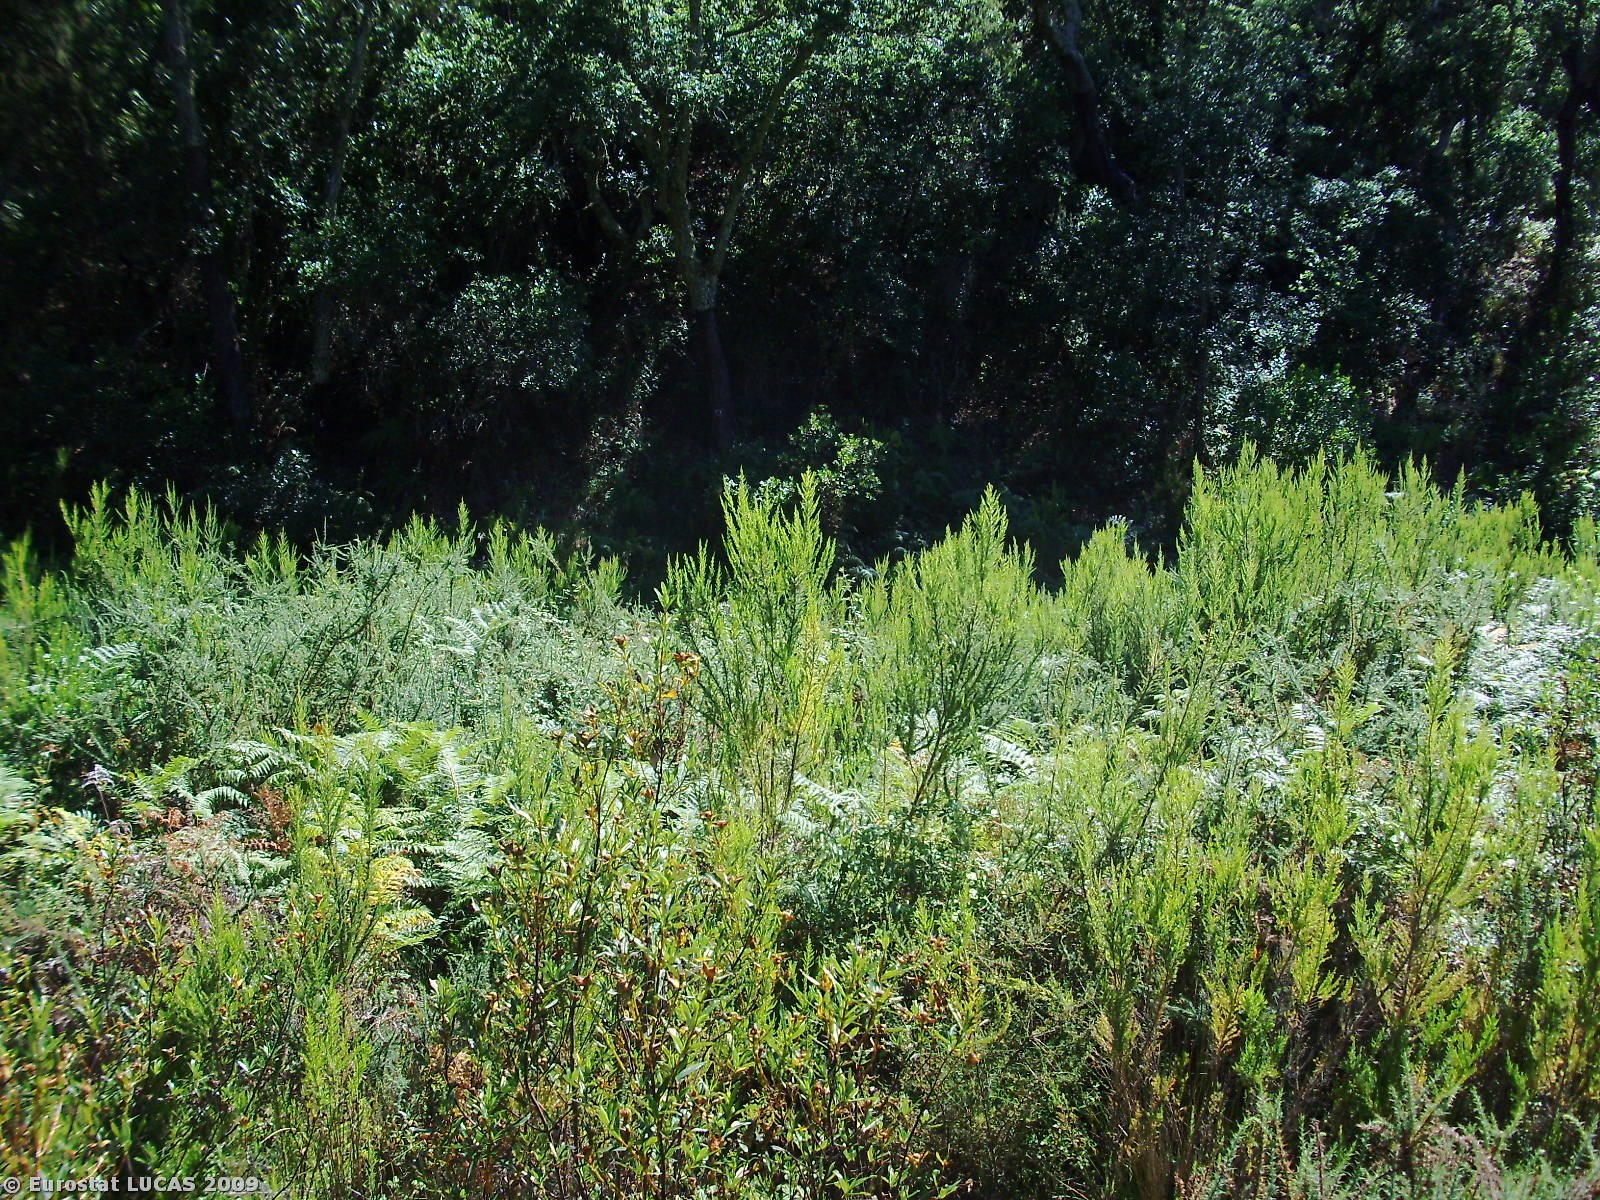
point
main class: Shrubland
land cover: Shrubland with sparse tree cover
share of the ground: > 75 %
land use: Unused
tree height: > 5 m
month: July
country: PT
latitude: 37.6439
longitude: -8.4742
